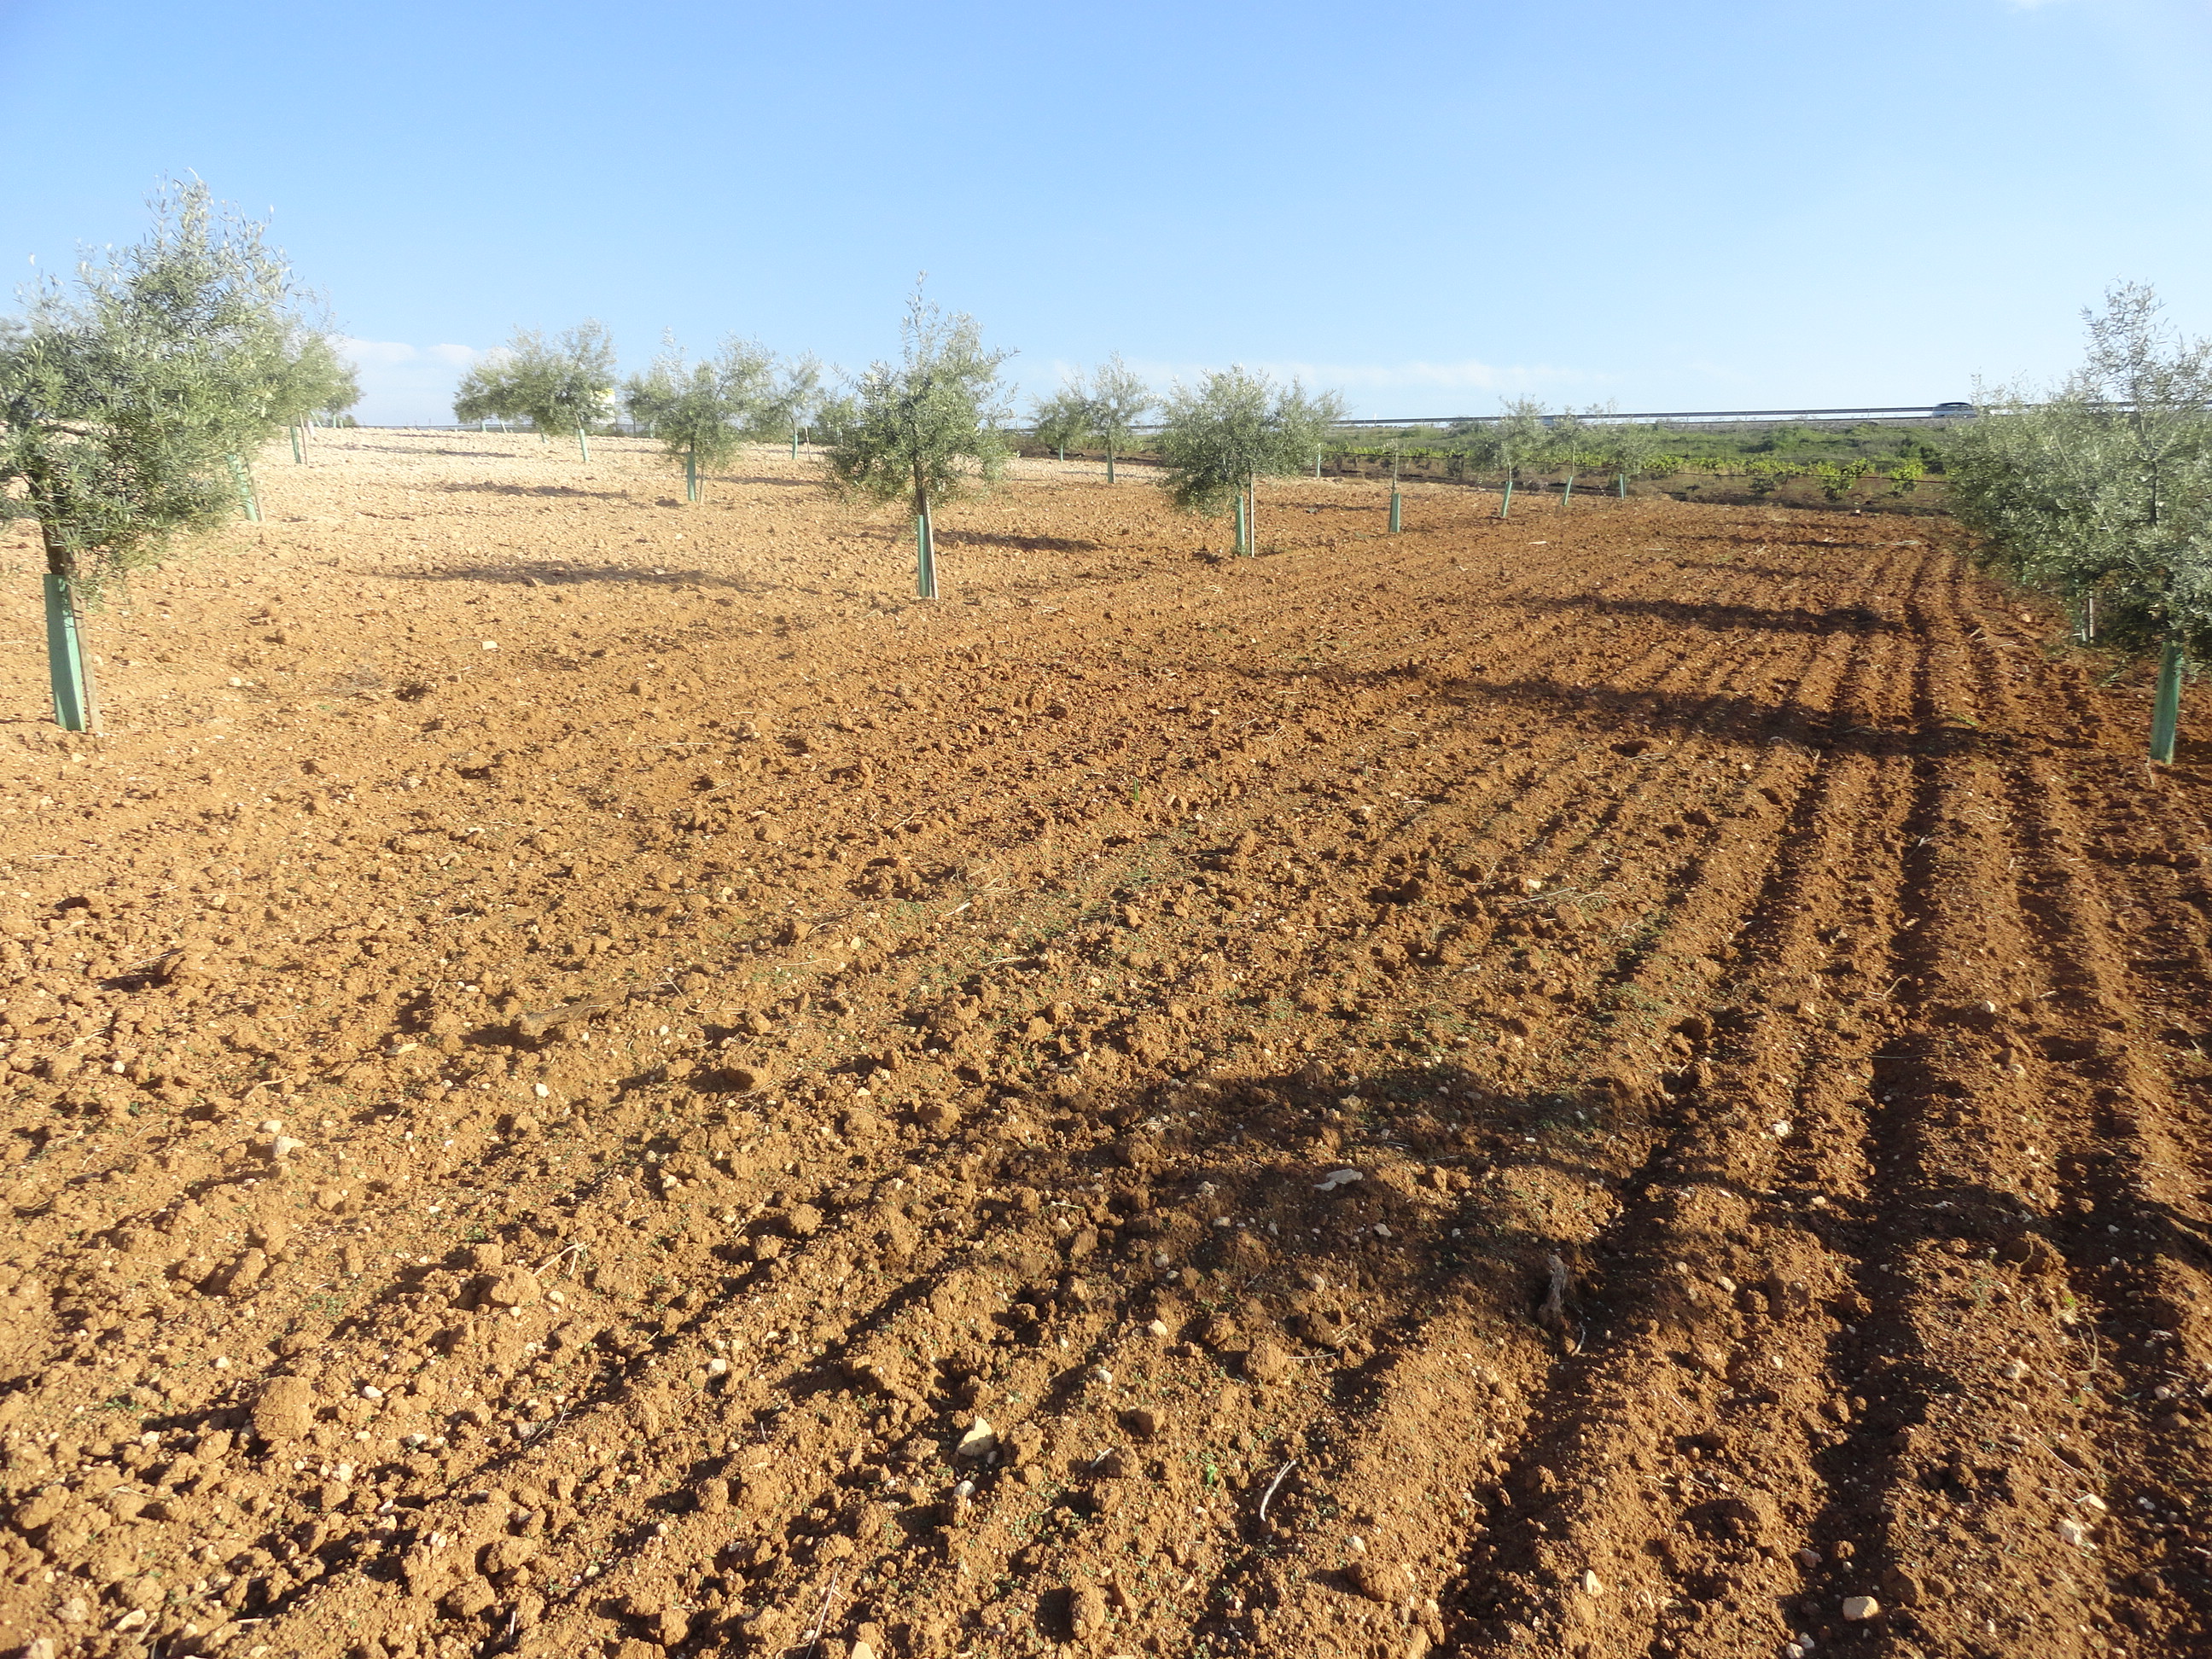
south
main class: Cropland
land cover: Olive groves
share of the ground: 10 - 25 %
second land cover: Other bare soil
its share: > 75 %
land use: Agriculture (excluding fallow land and kitchen gardens)
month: April
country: ES
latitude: 37.4635
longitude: -4.5781
